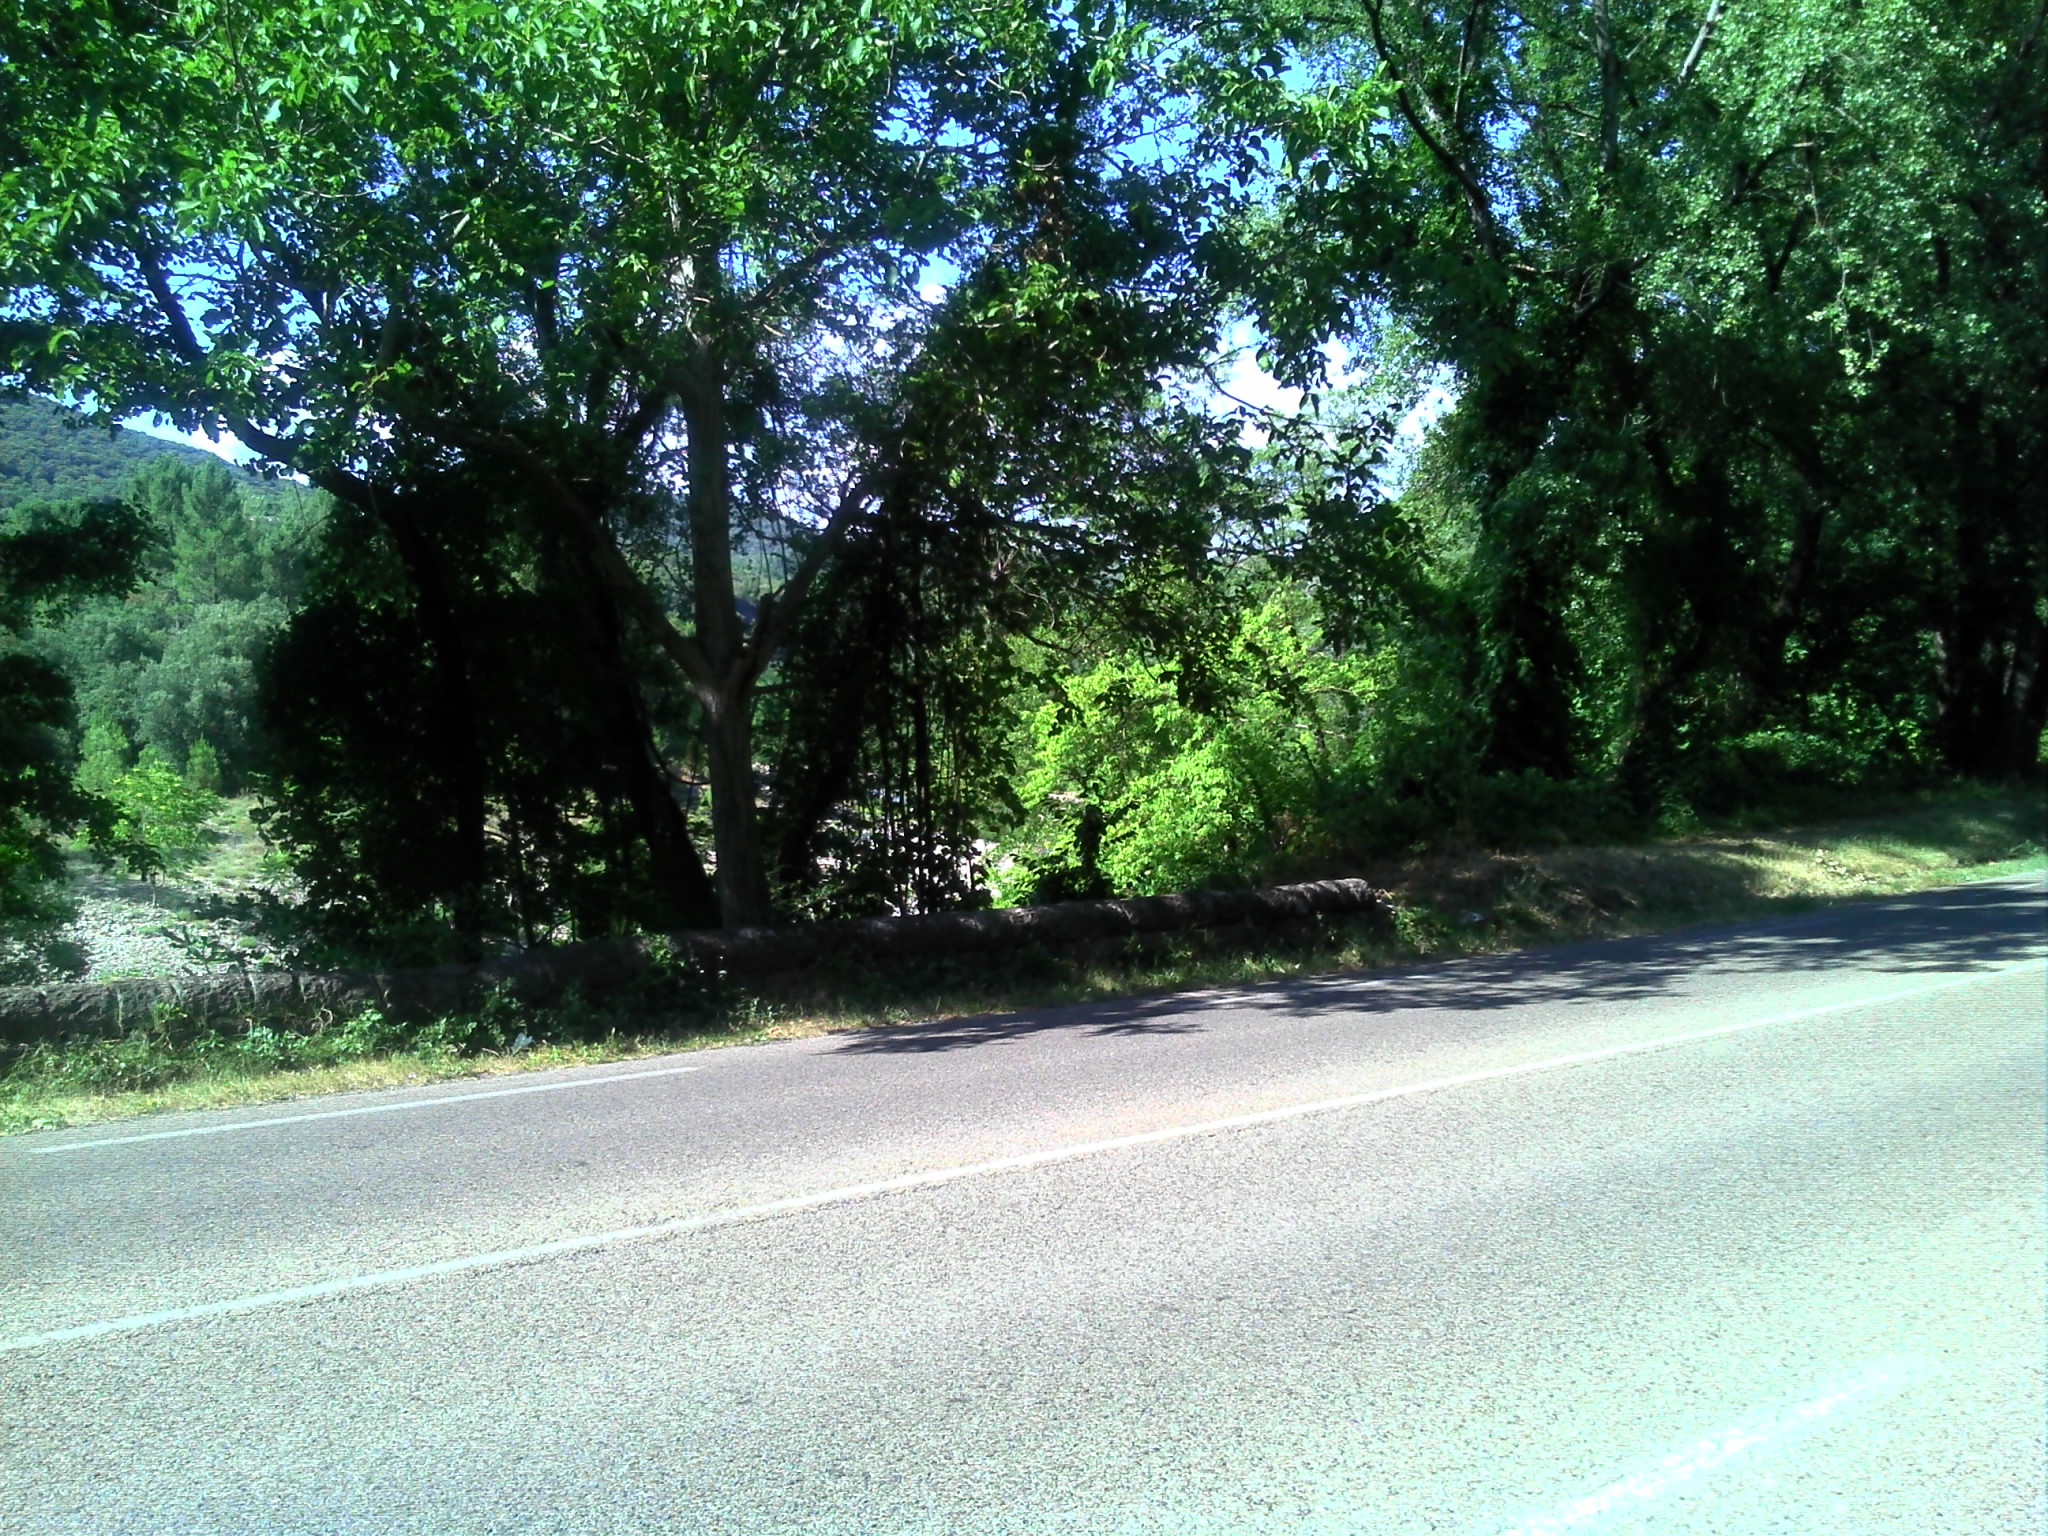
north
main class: Woodland
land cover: Broadleaved woodland
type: broadleaved evergreen forest
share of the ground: > 75 %
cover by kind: broadleaved forest trees 90 %, herbaceous plants 10 %
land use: Forestry
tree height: > 5 m
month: July
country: FR
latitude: 44.0656
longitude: 3.9525
